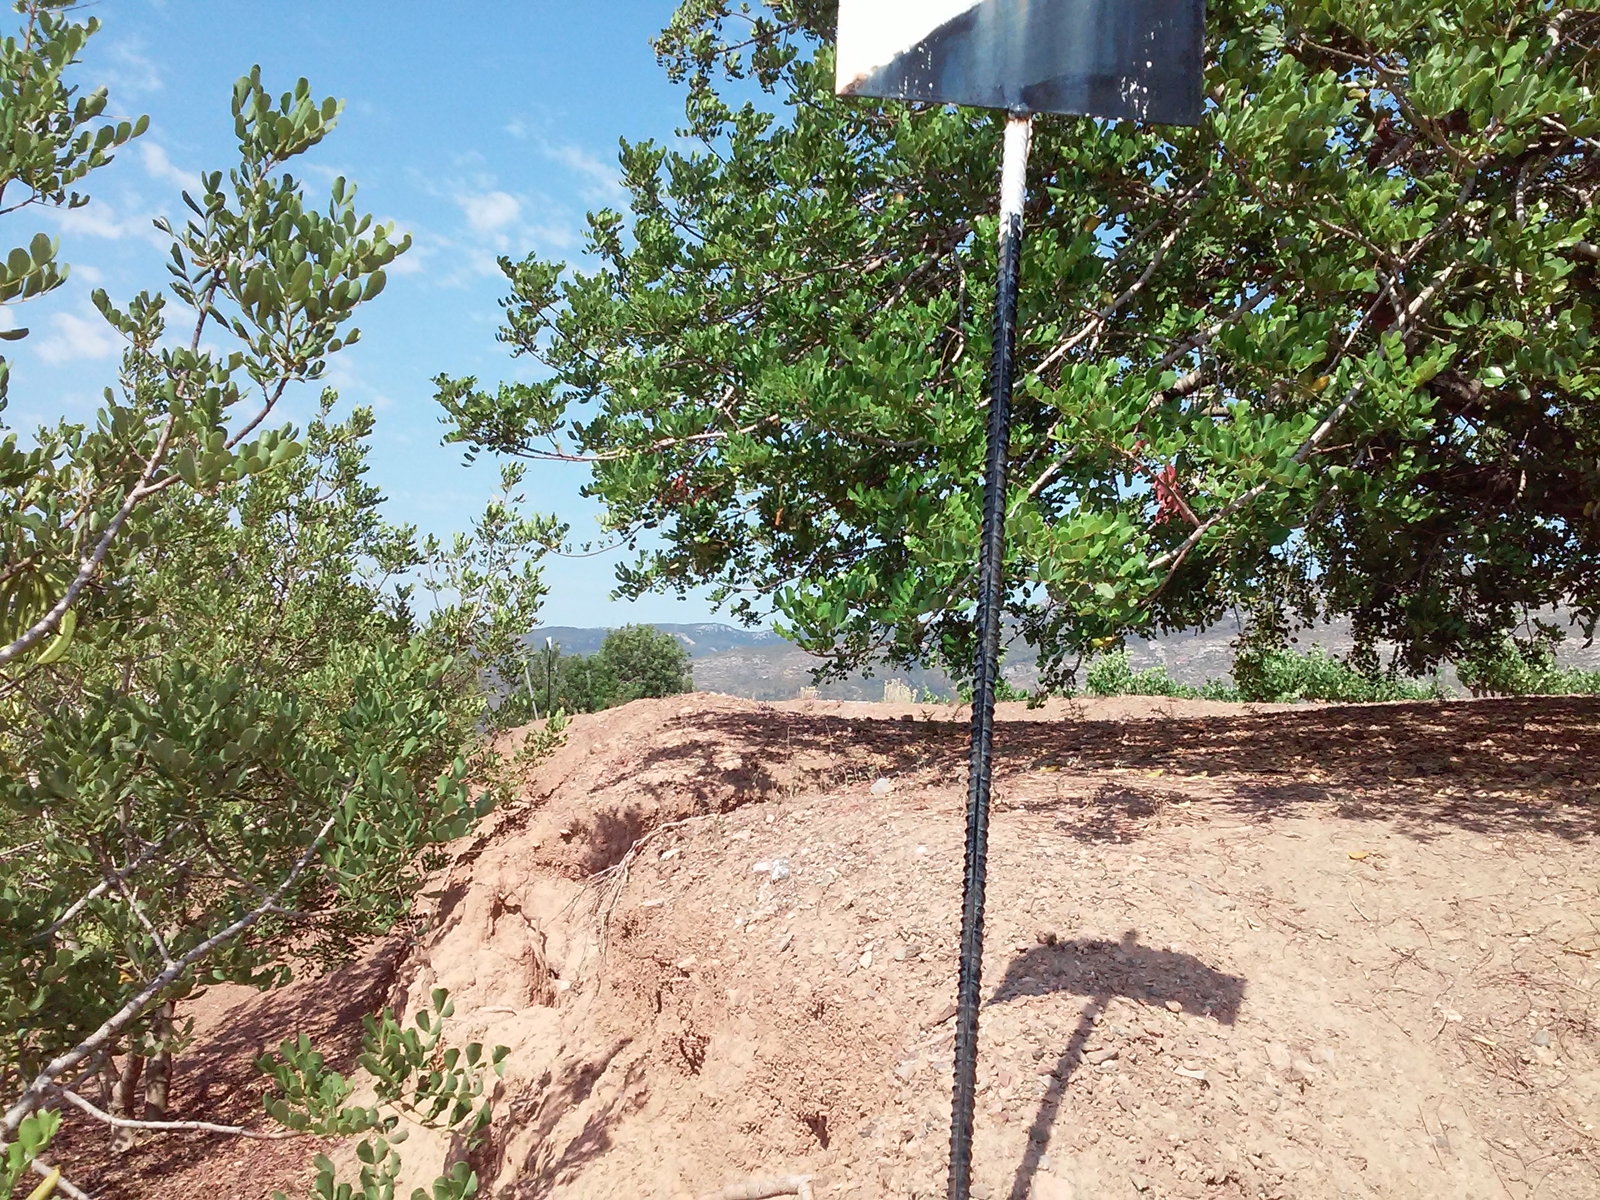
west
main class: Cropland
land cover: Permanent industrial crops
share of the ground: > 75 %
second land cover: Other bare soil
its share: > 75 %
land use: Agriculture (excluding fallow land and kitchen gardens)
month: June
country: ES
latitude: 41.2909
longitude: 1.2158
